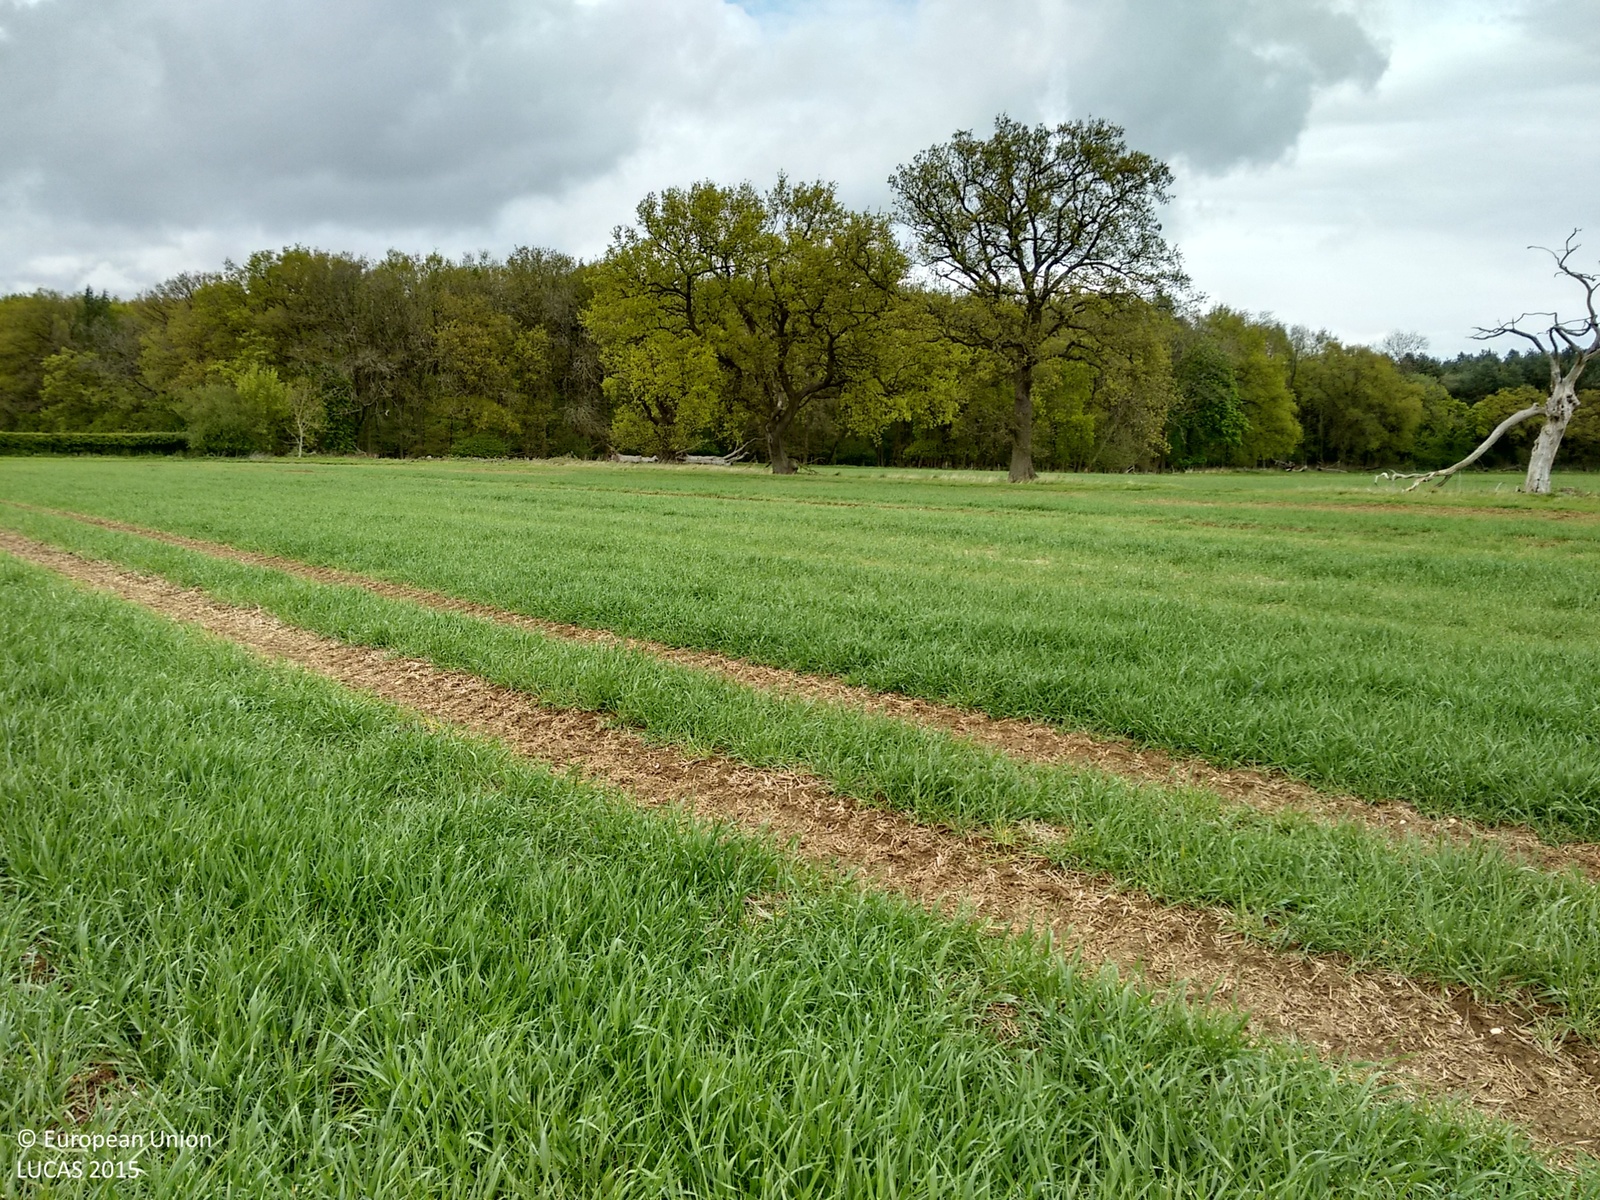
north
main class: Cropland
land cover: Barley
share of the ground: > 75 %
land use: Agriculture (excluding fallow land and kitchen gardens)
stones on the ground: 25 - 50 %
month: May
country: GB
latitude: 51.9694
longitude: -0.6513
